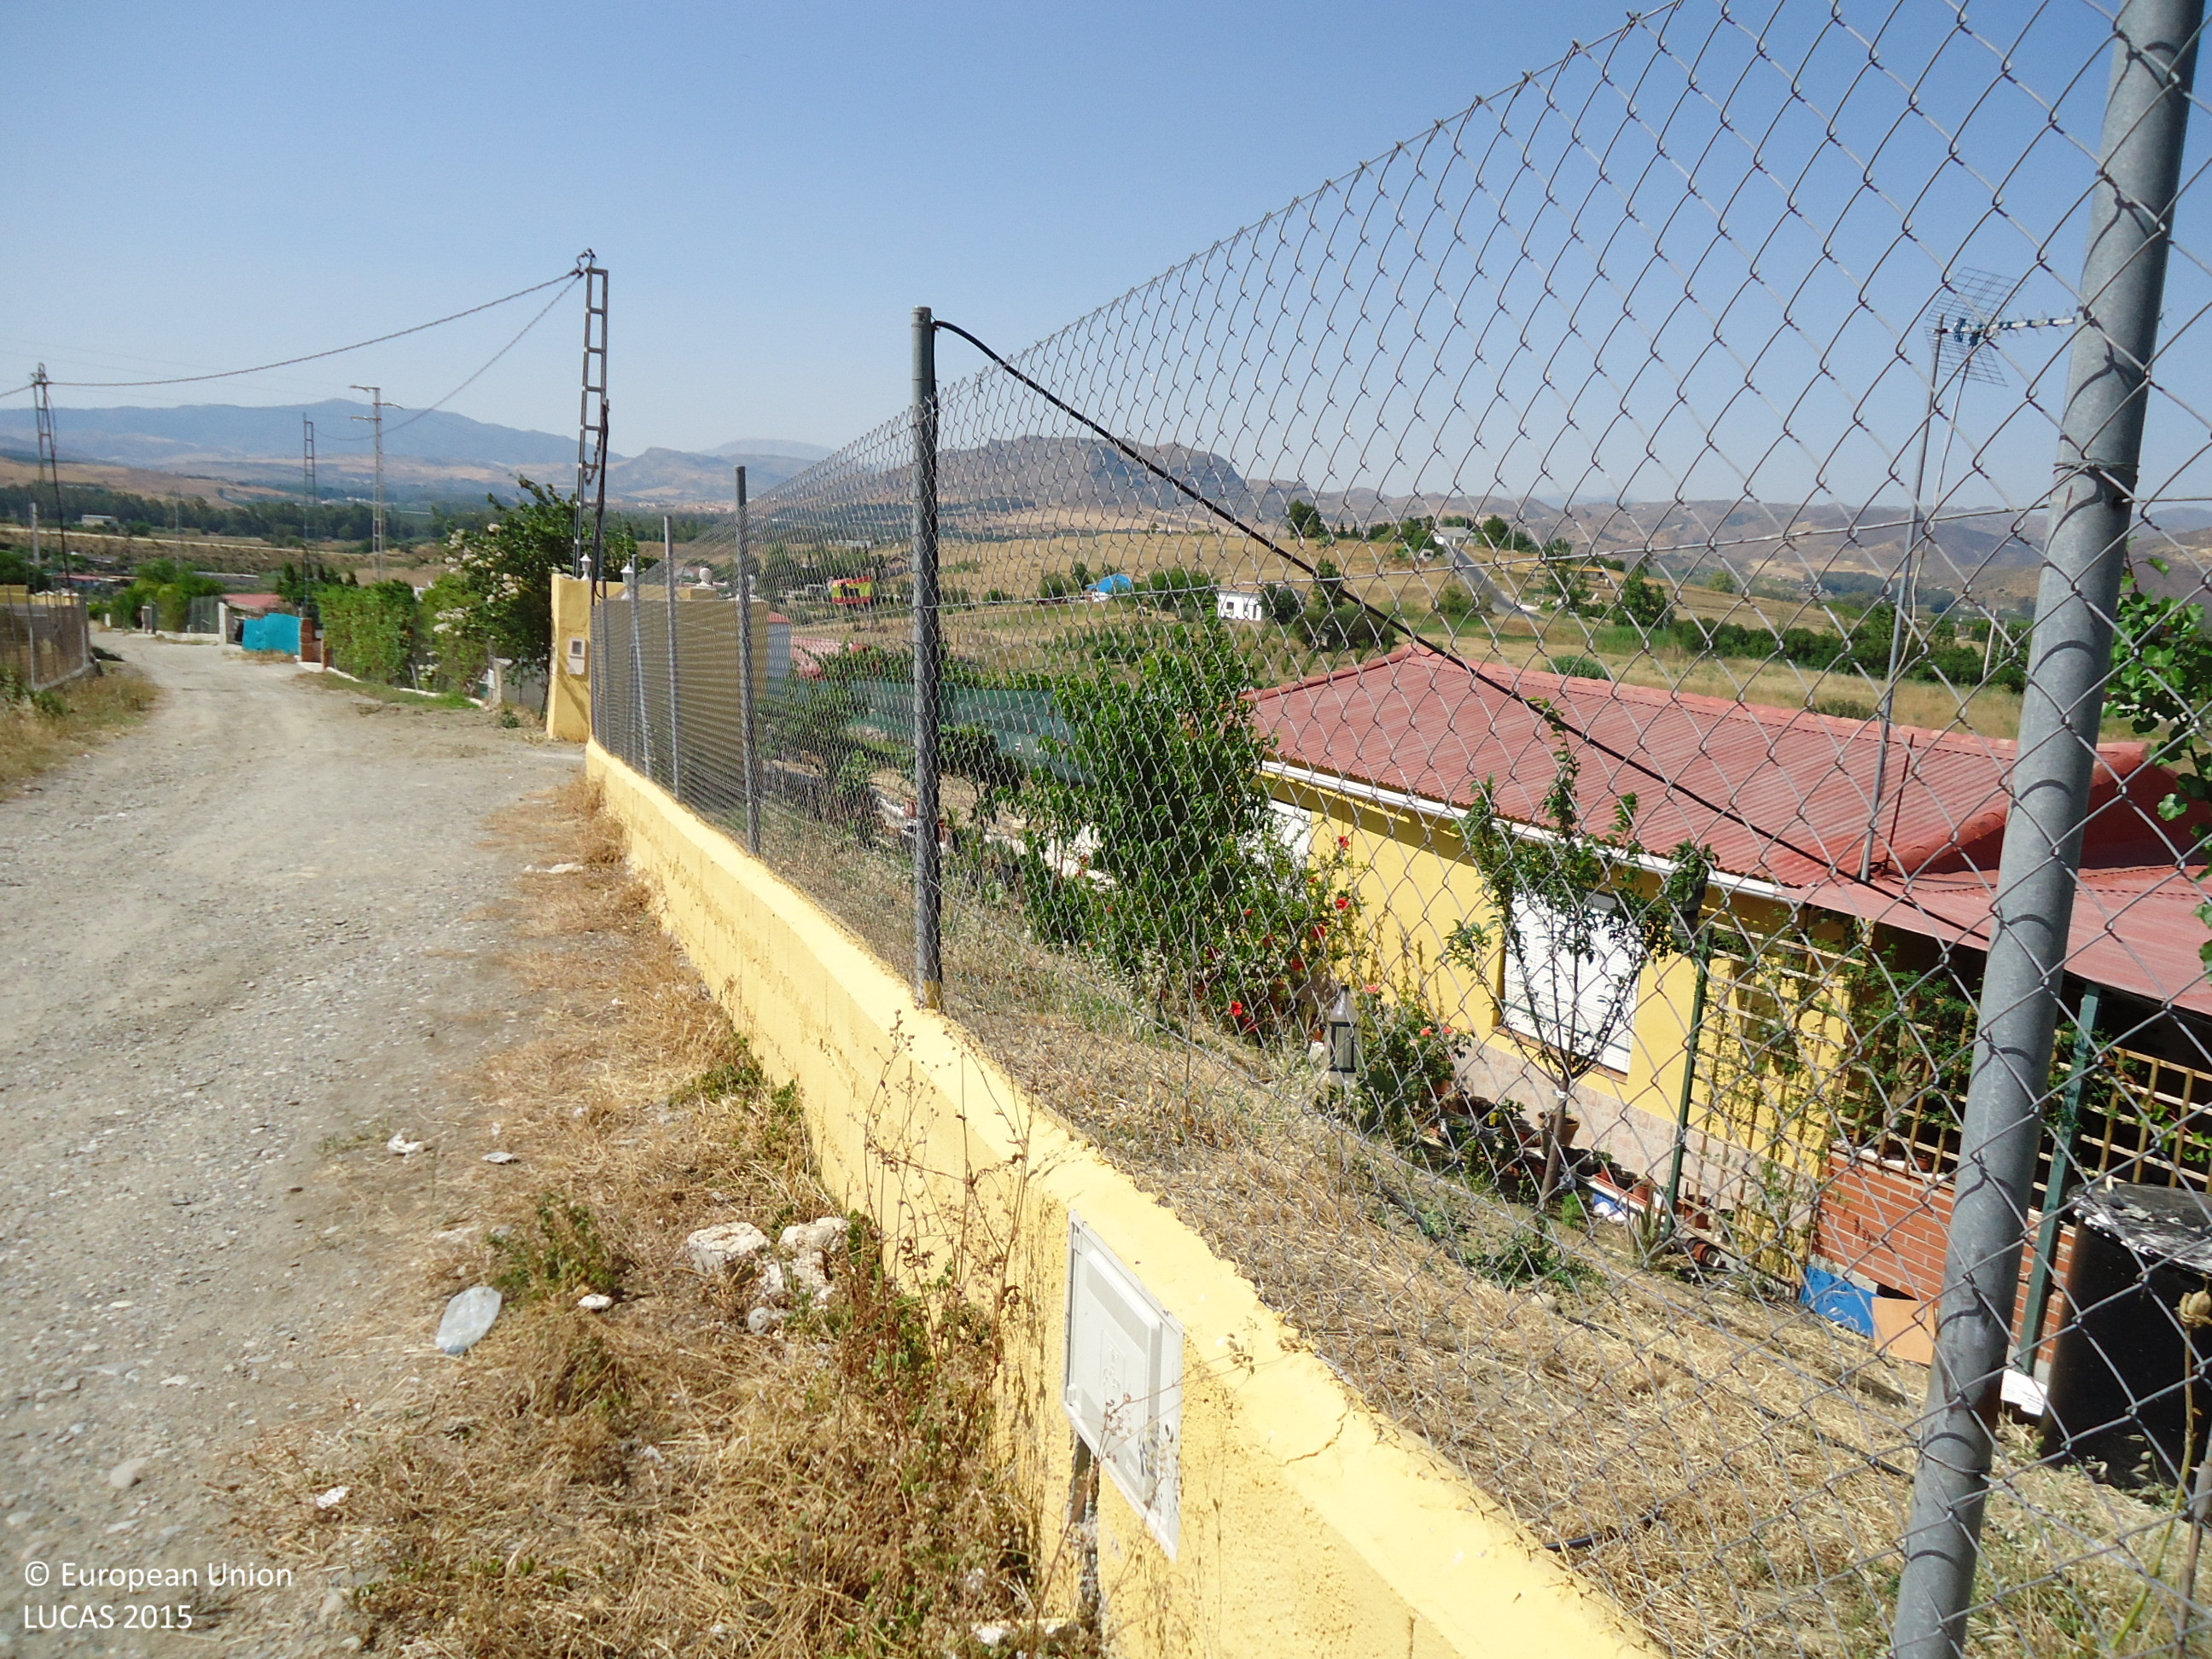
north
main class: Cropland
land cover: Other fresh vegetables
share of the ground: 25 - 50 %
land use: Kitchen garden
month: June
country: ES
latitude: 36.7102
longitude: -4.6913
